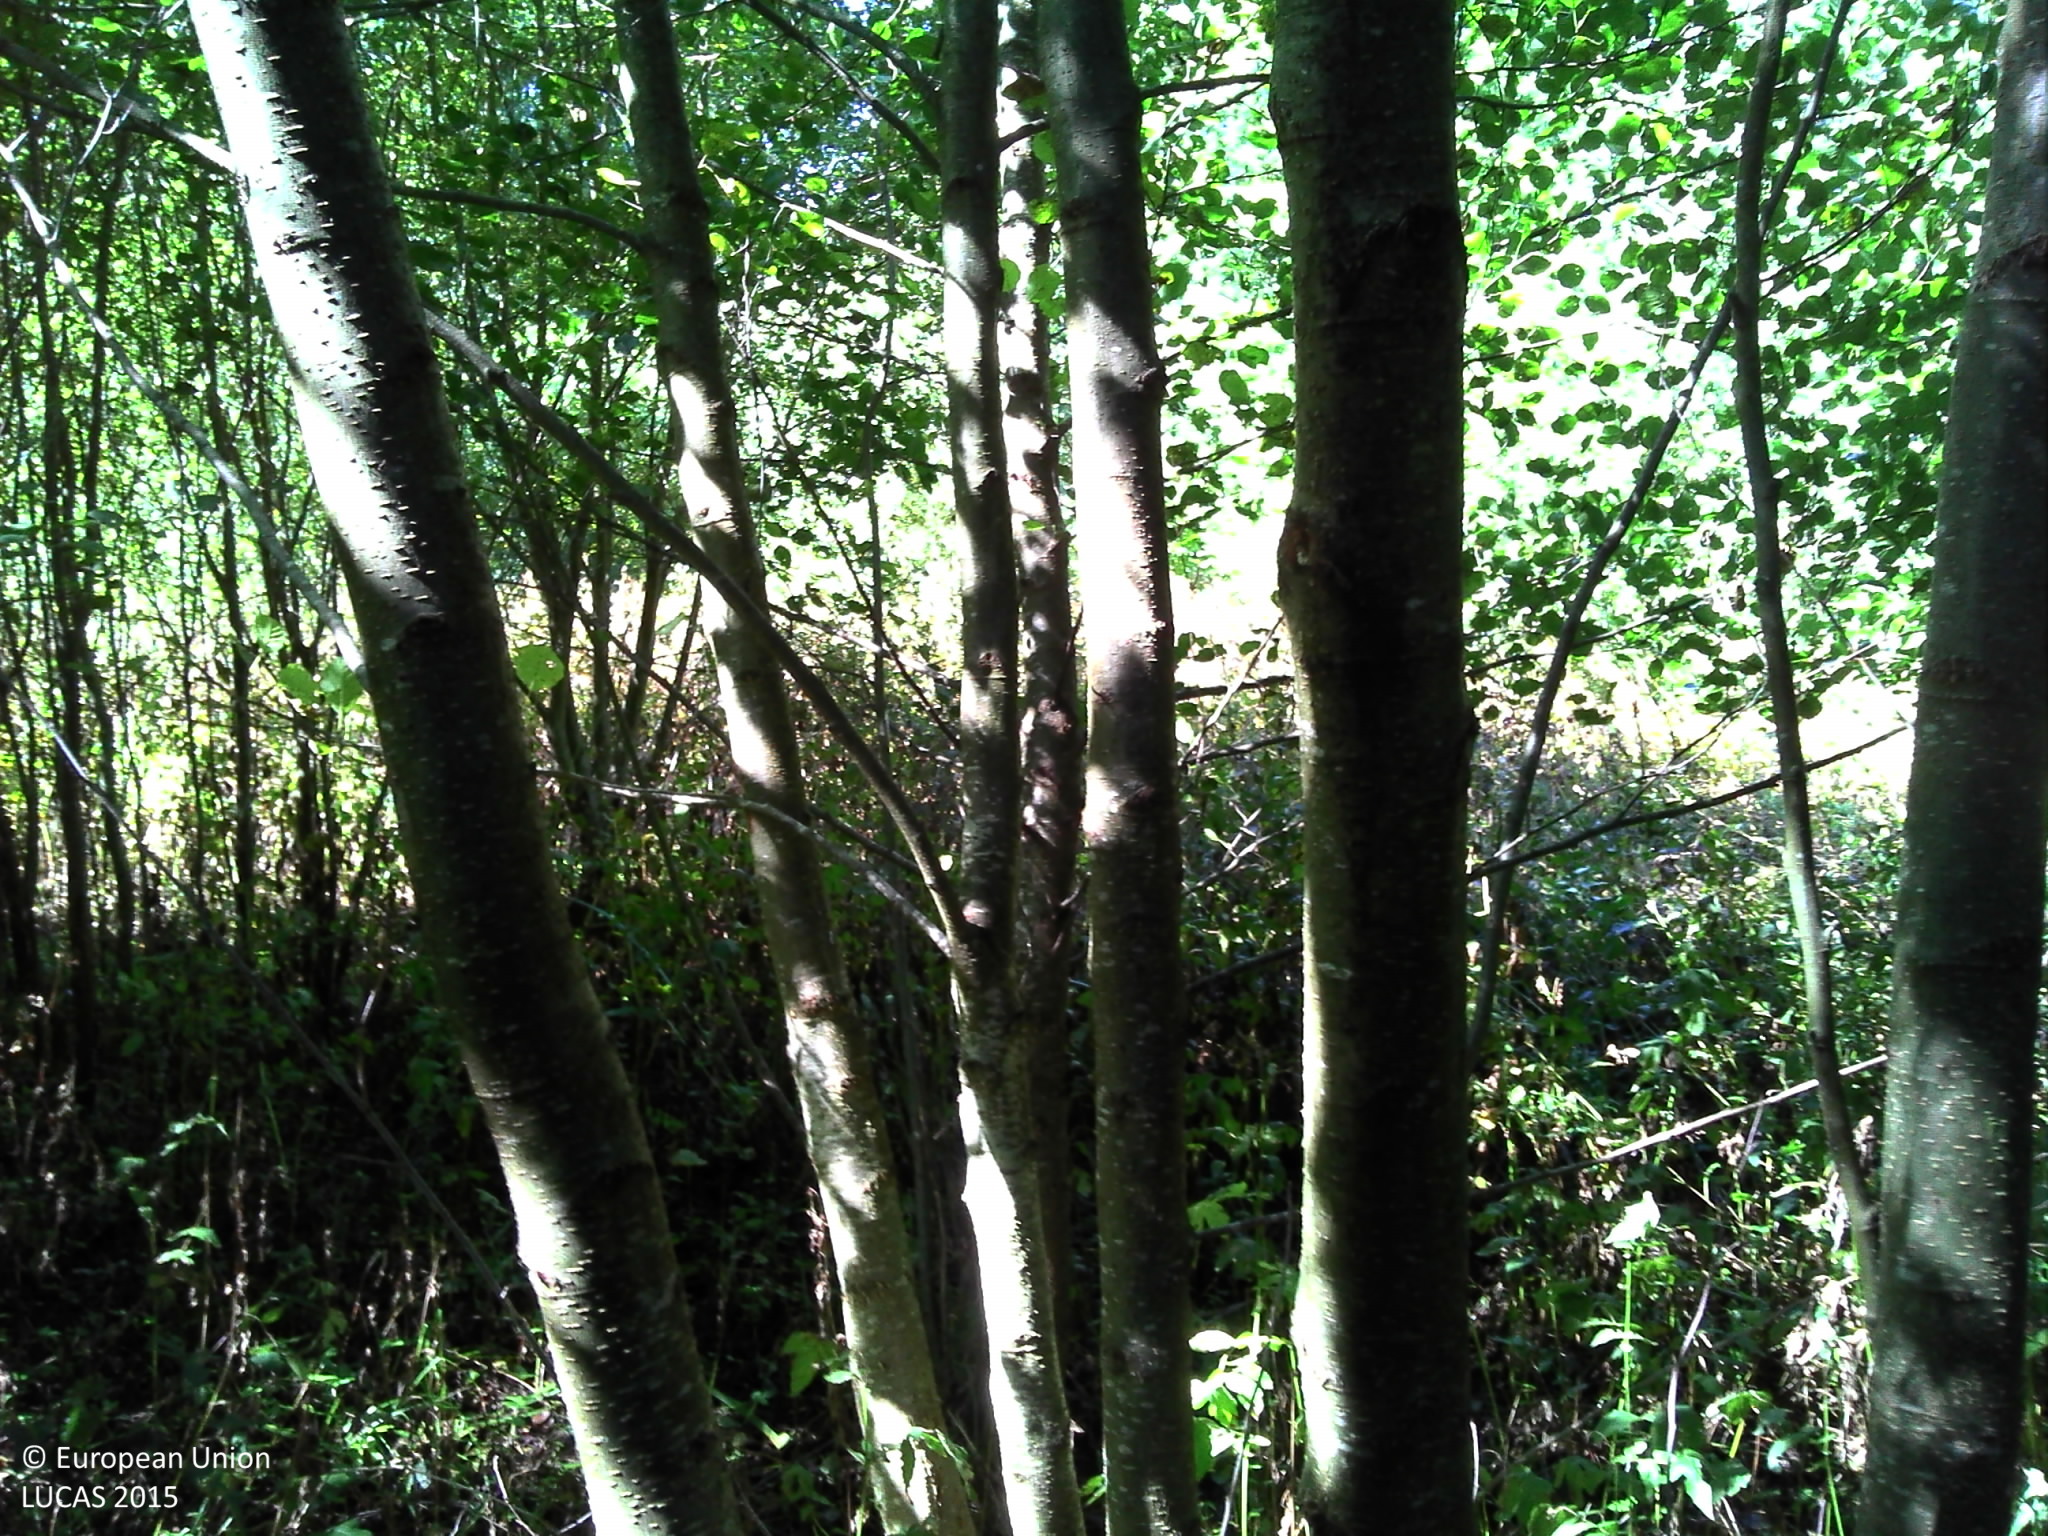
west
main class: Woodland
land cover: Broadleaved woodland
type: non-riverine alder, birch or aspen forest
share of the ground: > 75 %
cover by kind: broadleaved forest trees 80 %, herbaceous plants 10 %, shrubs 5 %, unconsolidated bare surface 5 %
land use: Semi-natural and natural areas not in use
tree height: > 5 m
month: September
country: FR
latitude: 45.8963
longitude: 2.8713
